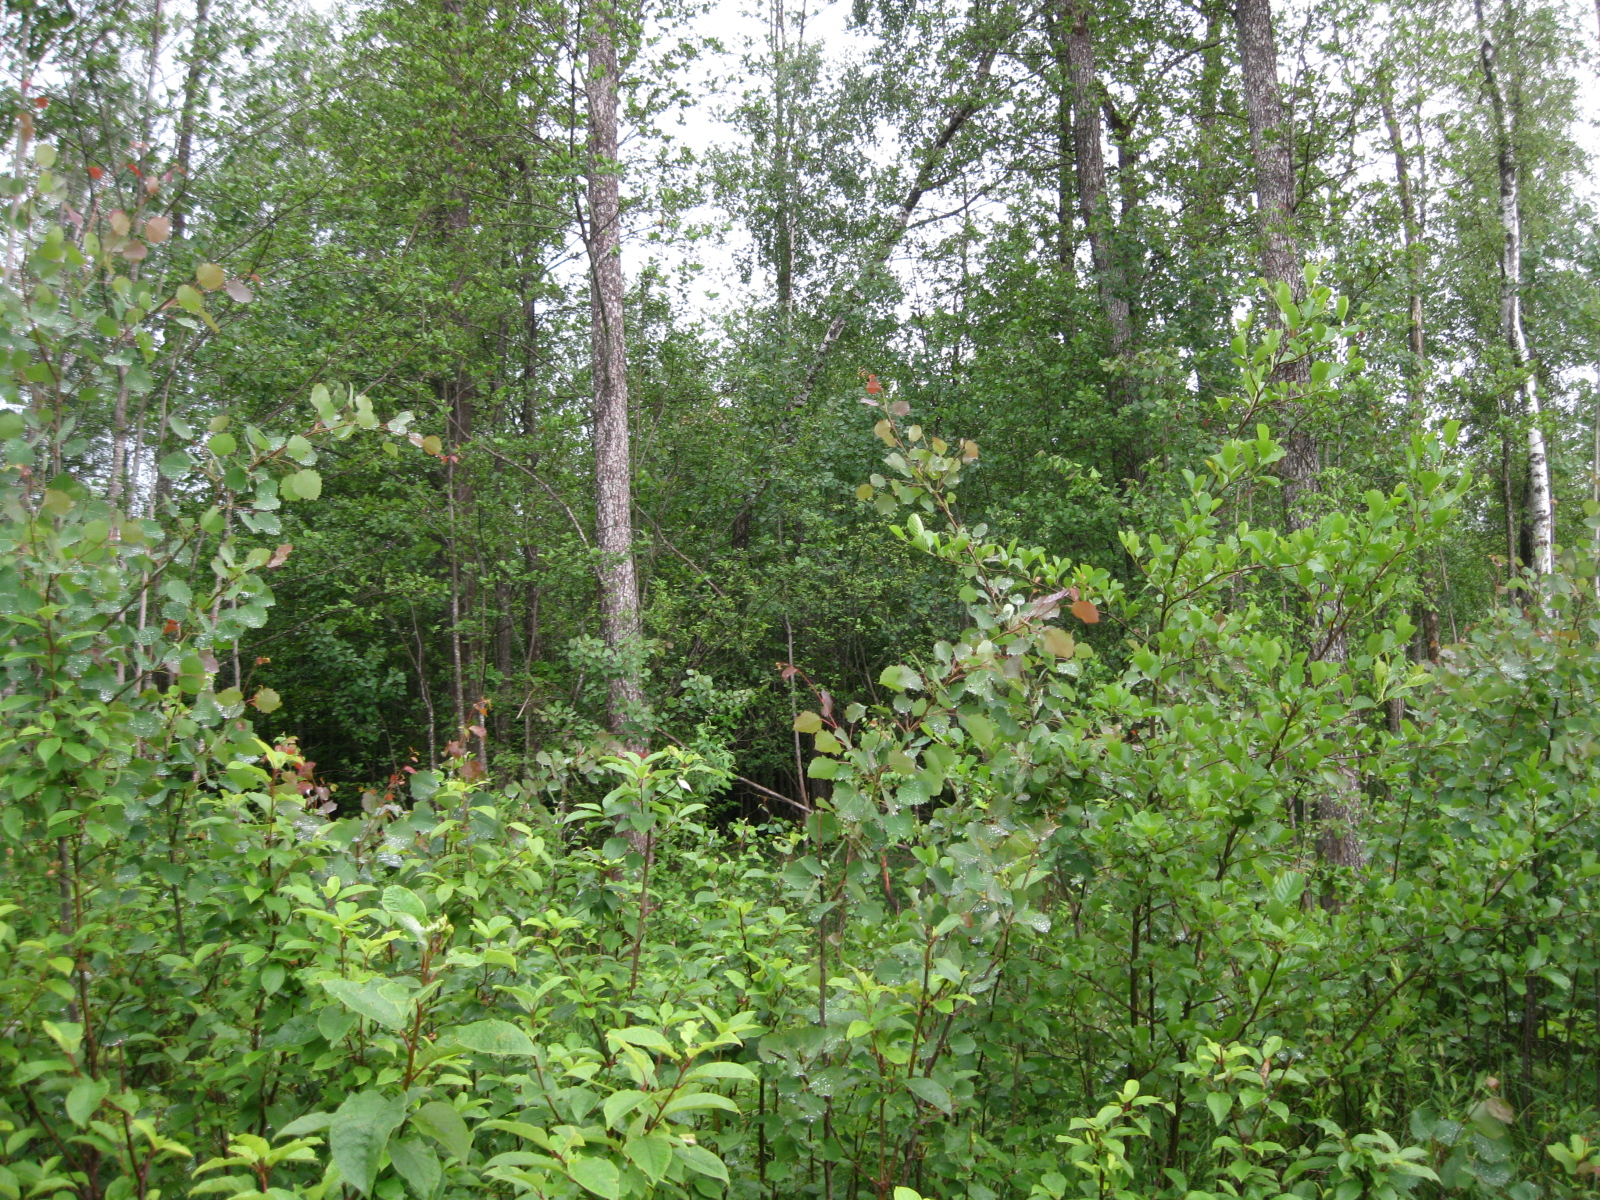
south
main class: Woodland
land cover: Broadleaved woodland
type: non-riverine alder, birch or aspen forest
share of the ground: > 75 %
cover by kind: broadleaved forest trees 80 %, herbaceous plants 15 %, shrubs 5 %
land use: Forestry
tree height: < 5 m
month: June
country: LT
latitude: 55.6532
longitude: 23.9945
